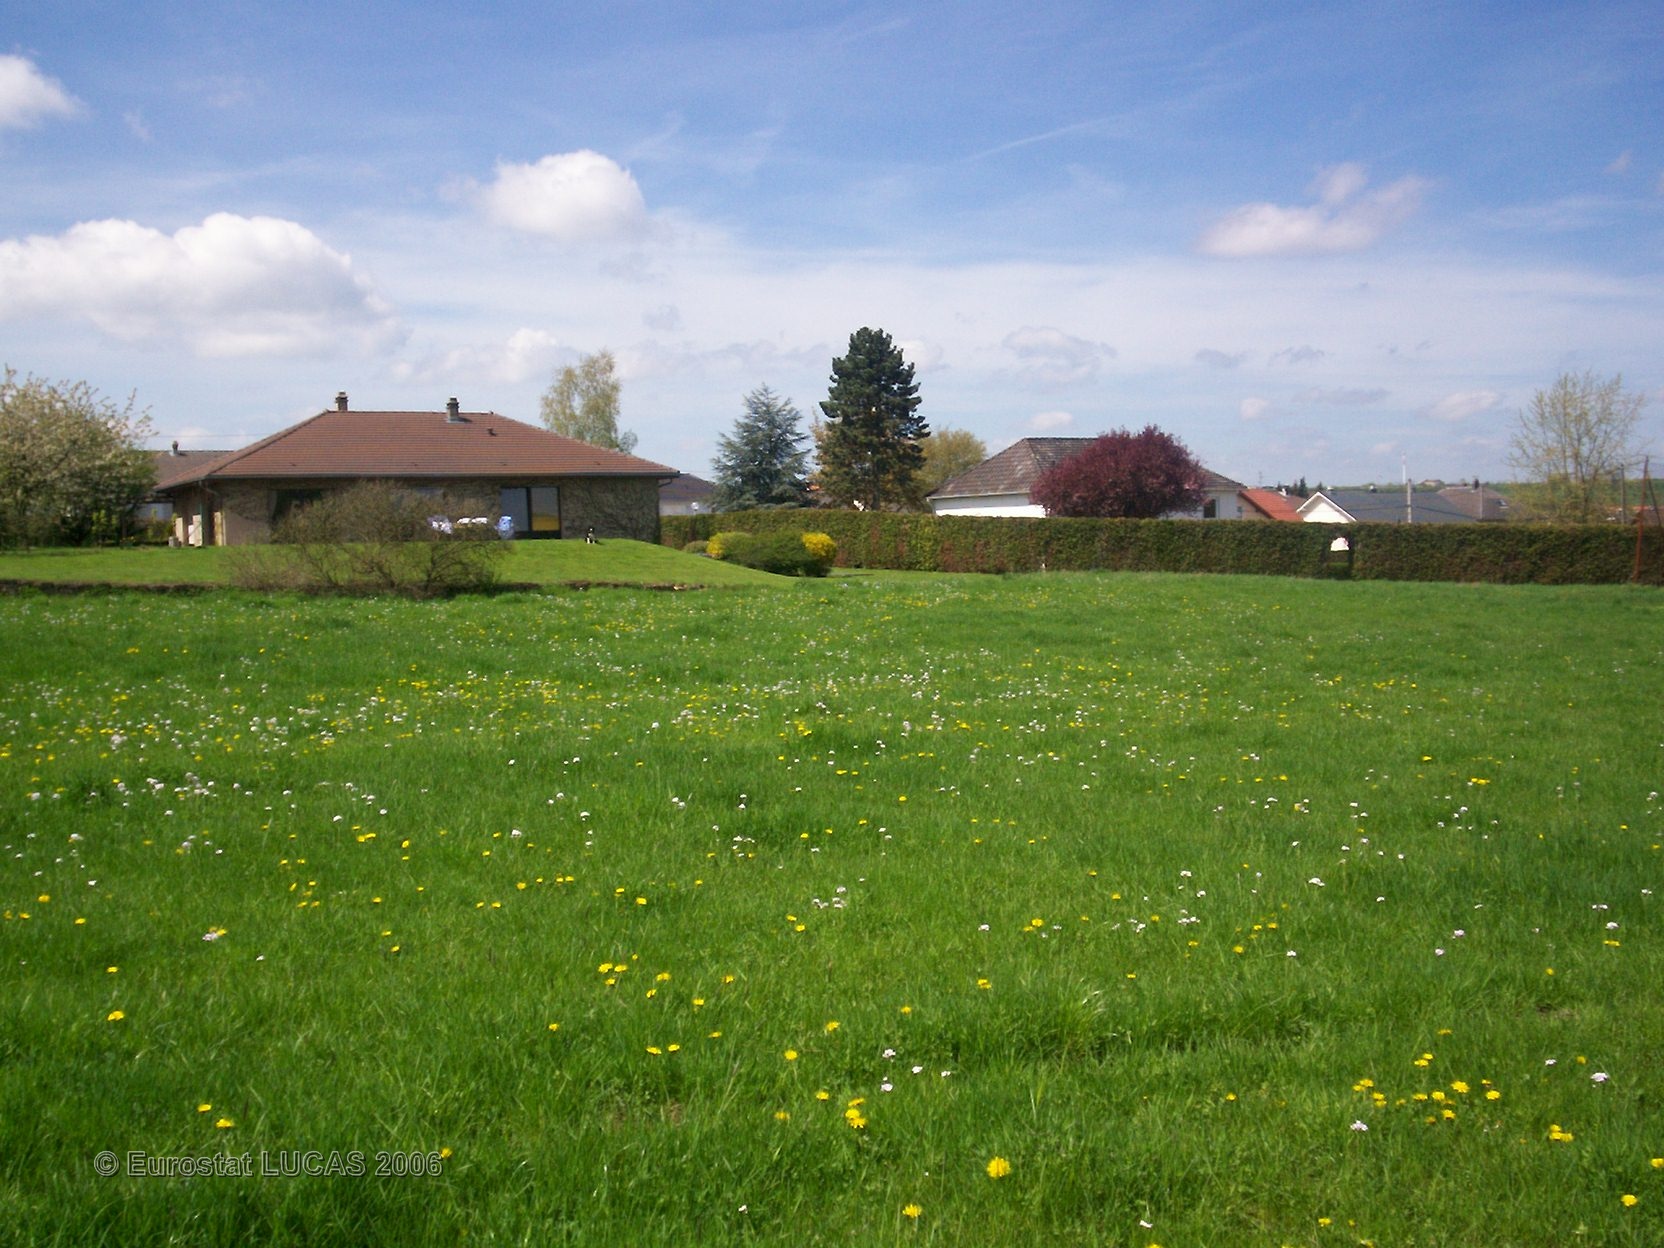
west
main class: Grassland
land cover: Grassland without tree/shrub cover
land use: Agriculture (excluding fallow land and kitchen gardens)
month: May
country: FR
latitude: 49.0941
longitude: 6.7546
